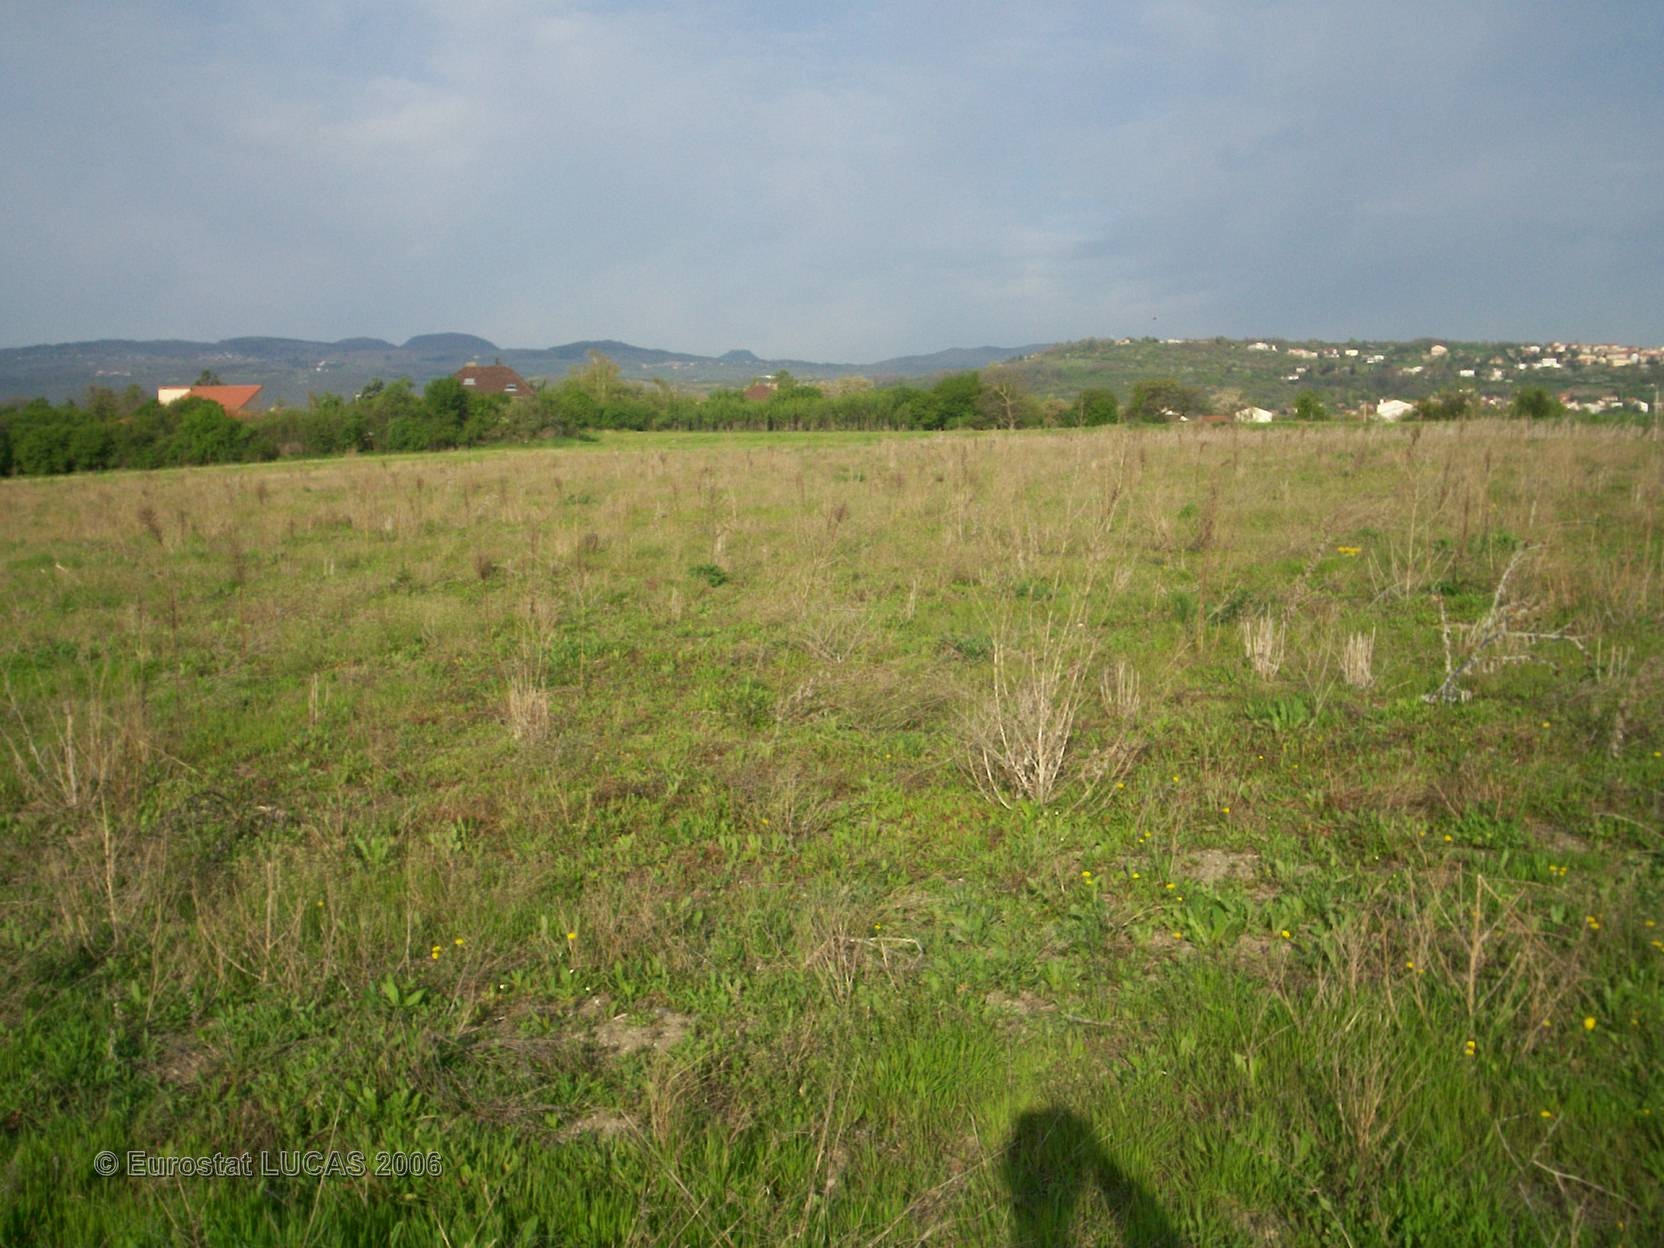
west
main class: Grassland
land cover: Grassland without tree/shrub cover
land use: Fallow land
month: April
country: FR
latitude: 45.8398
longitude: 3.1113
